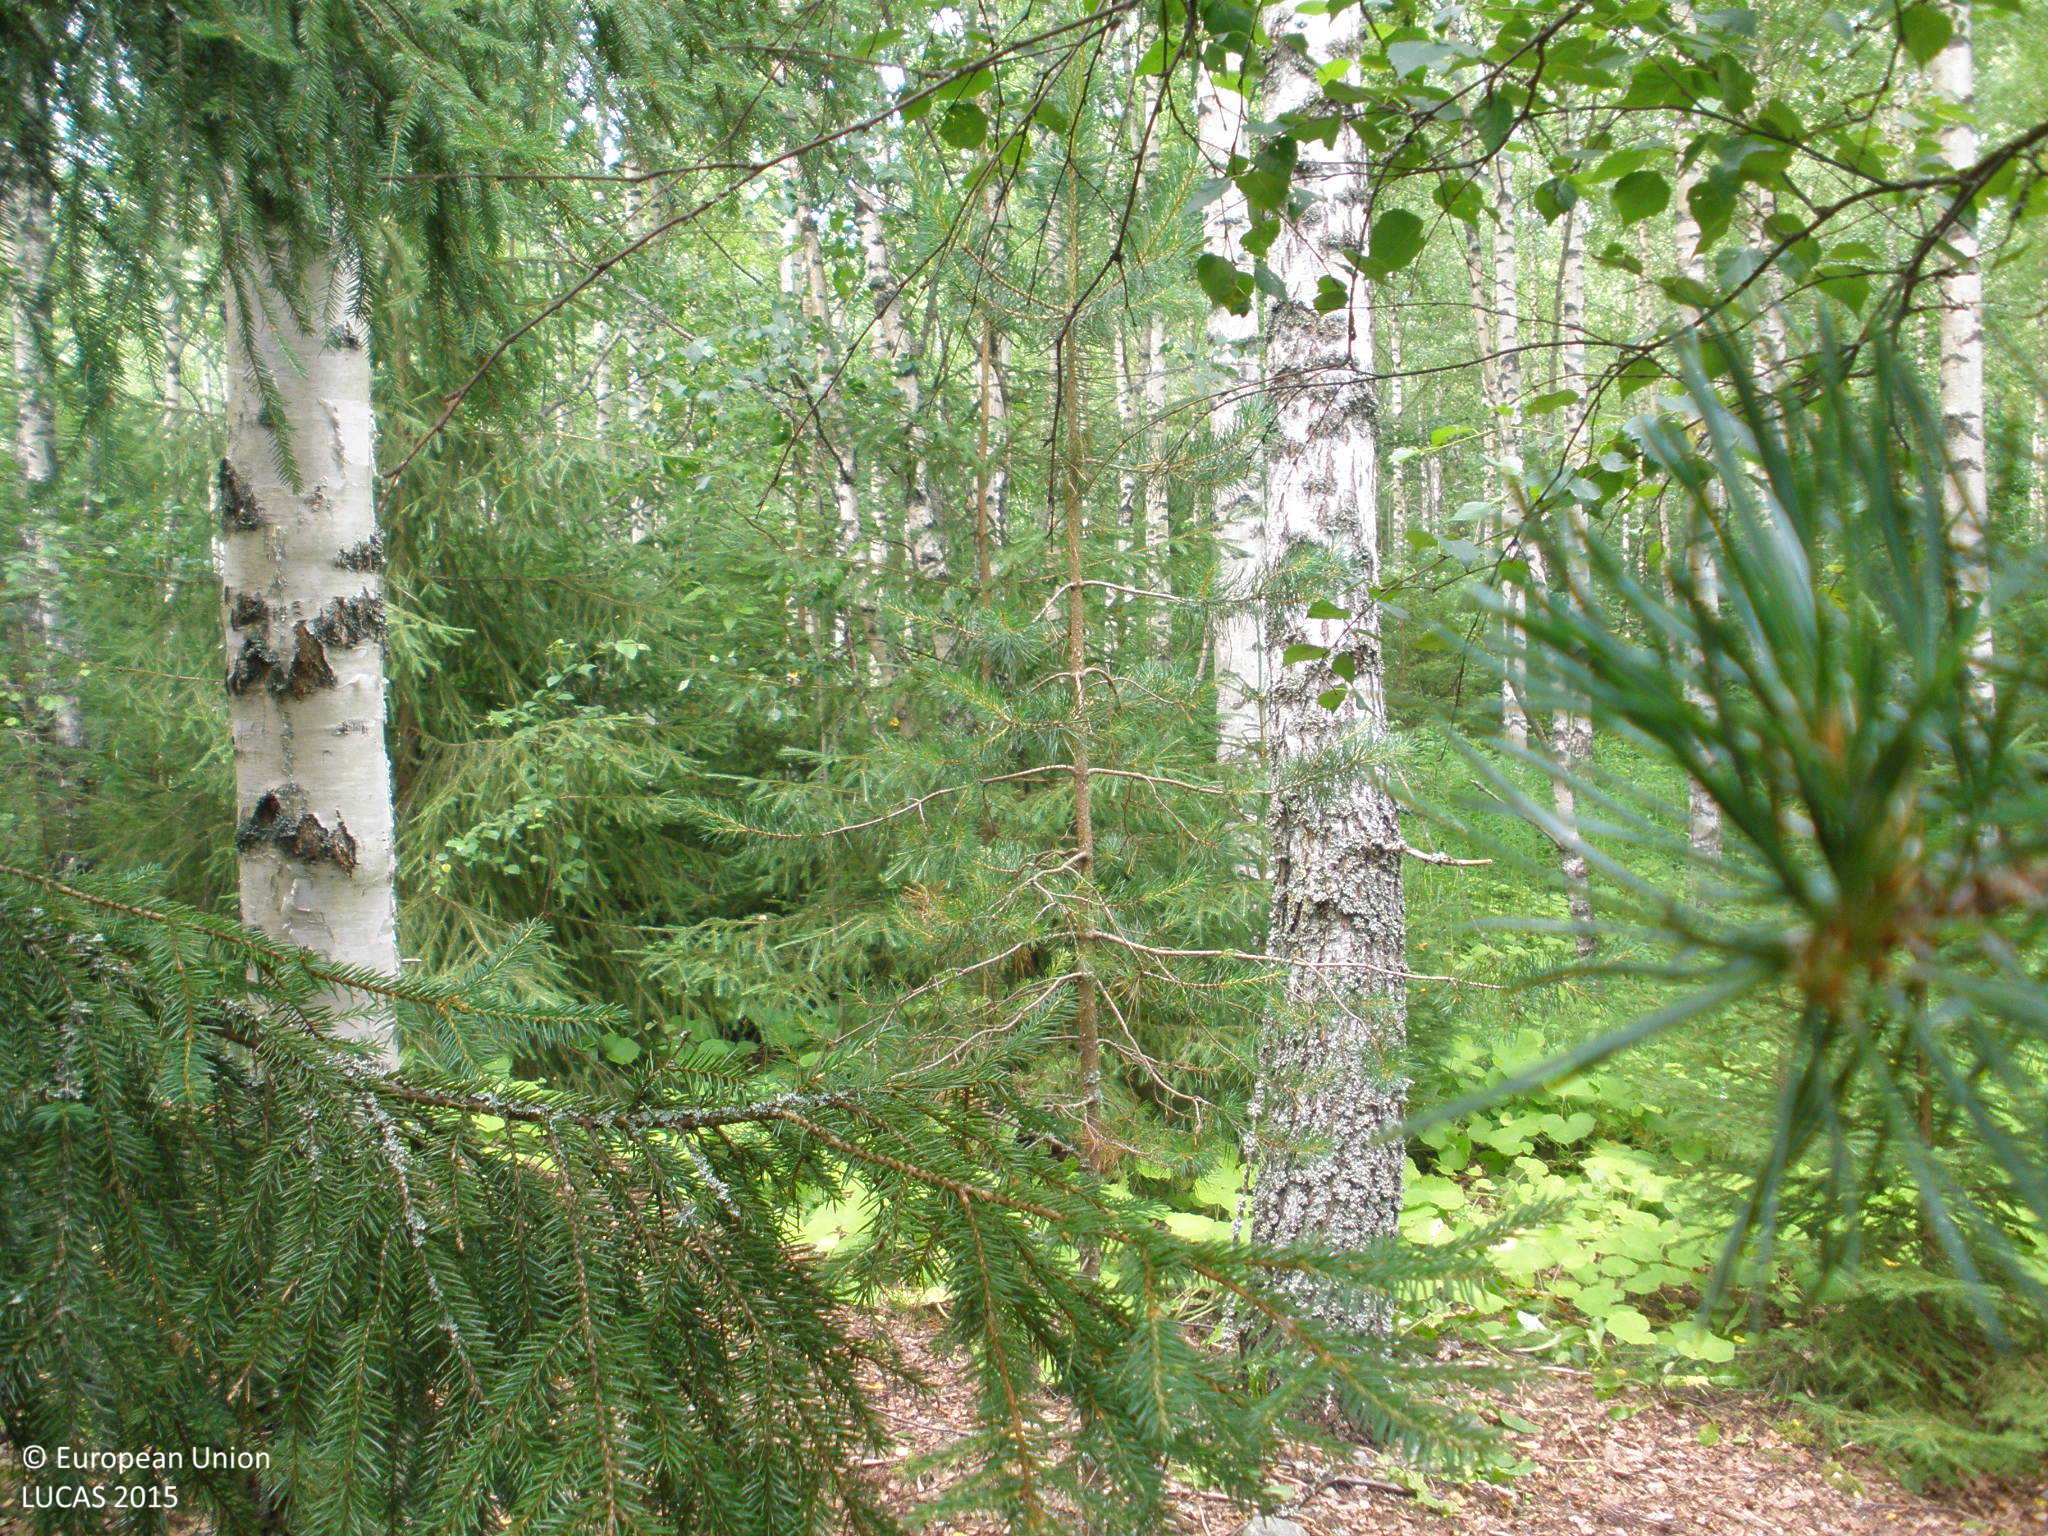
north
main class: Woodland
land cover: Spruce dominated mixed woodland
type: boreal forest
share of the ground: > 75 %
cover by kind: broadleaved forest trees 50 %, coniferous forest trees 25 %, herbaceous plants 20 %, shrubs 5 %
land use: Forestry
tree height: > 5 m
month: July
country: FI
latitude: 60.9520
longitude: 24.1083
